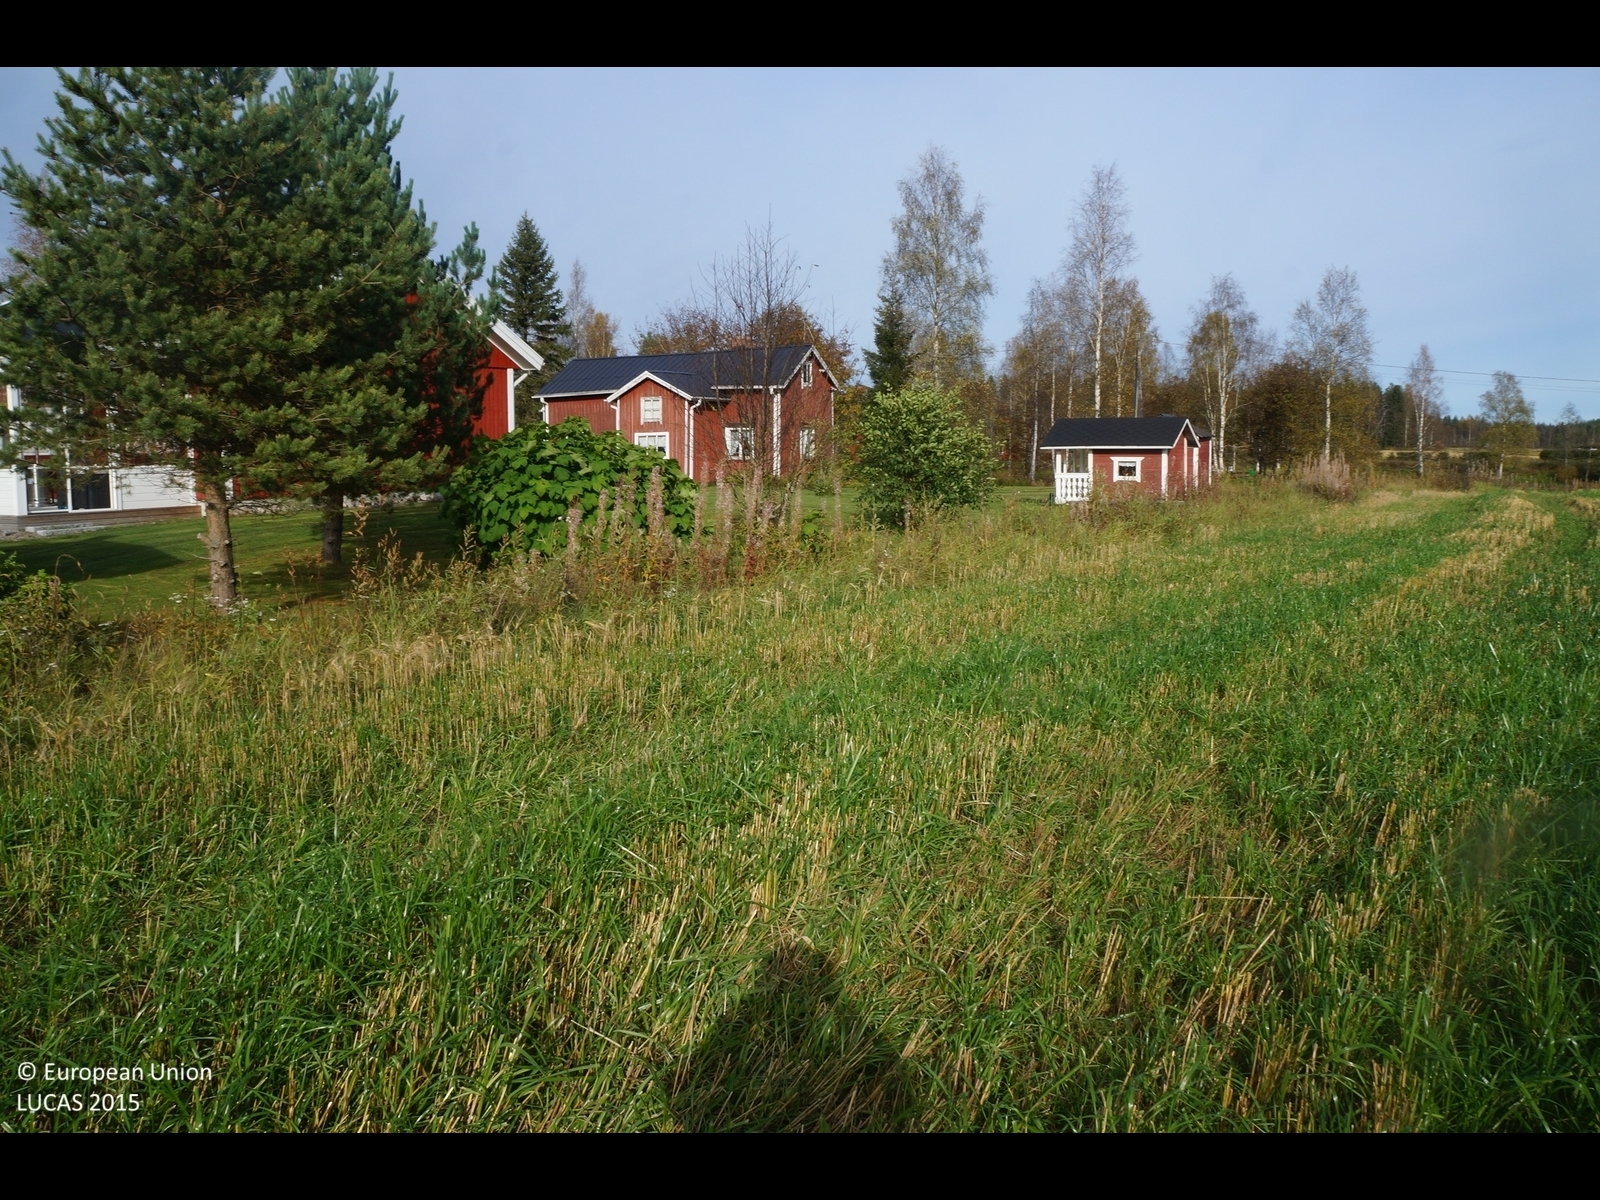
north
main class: Cropland
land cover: Temporary grasslands
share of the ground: > 75 %
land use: Agriculture (excluding fallow land and kitchen gardens)
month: September
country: FI
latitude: 63.8755
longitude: 24.0932
